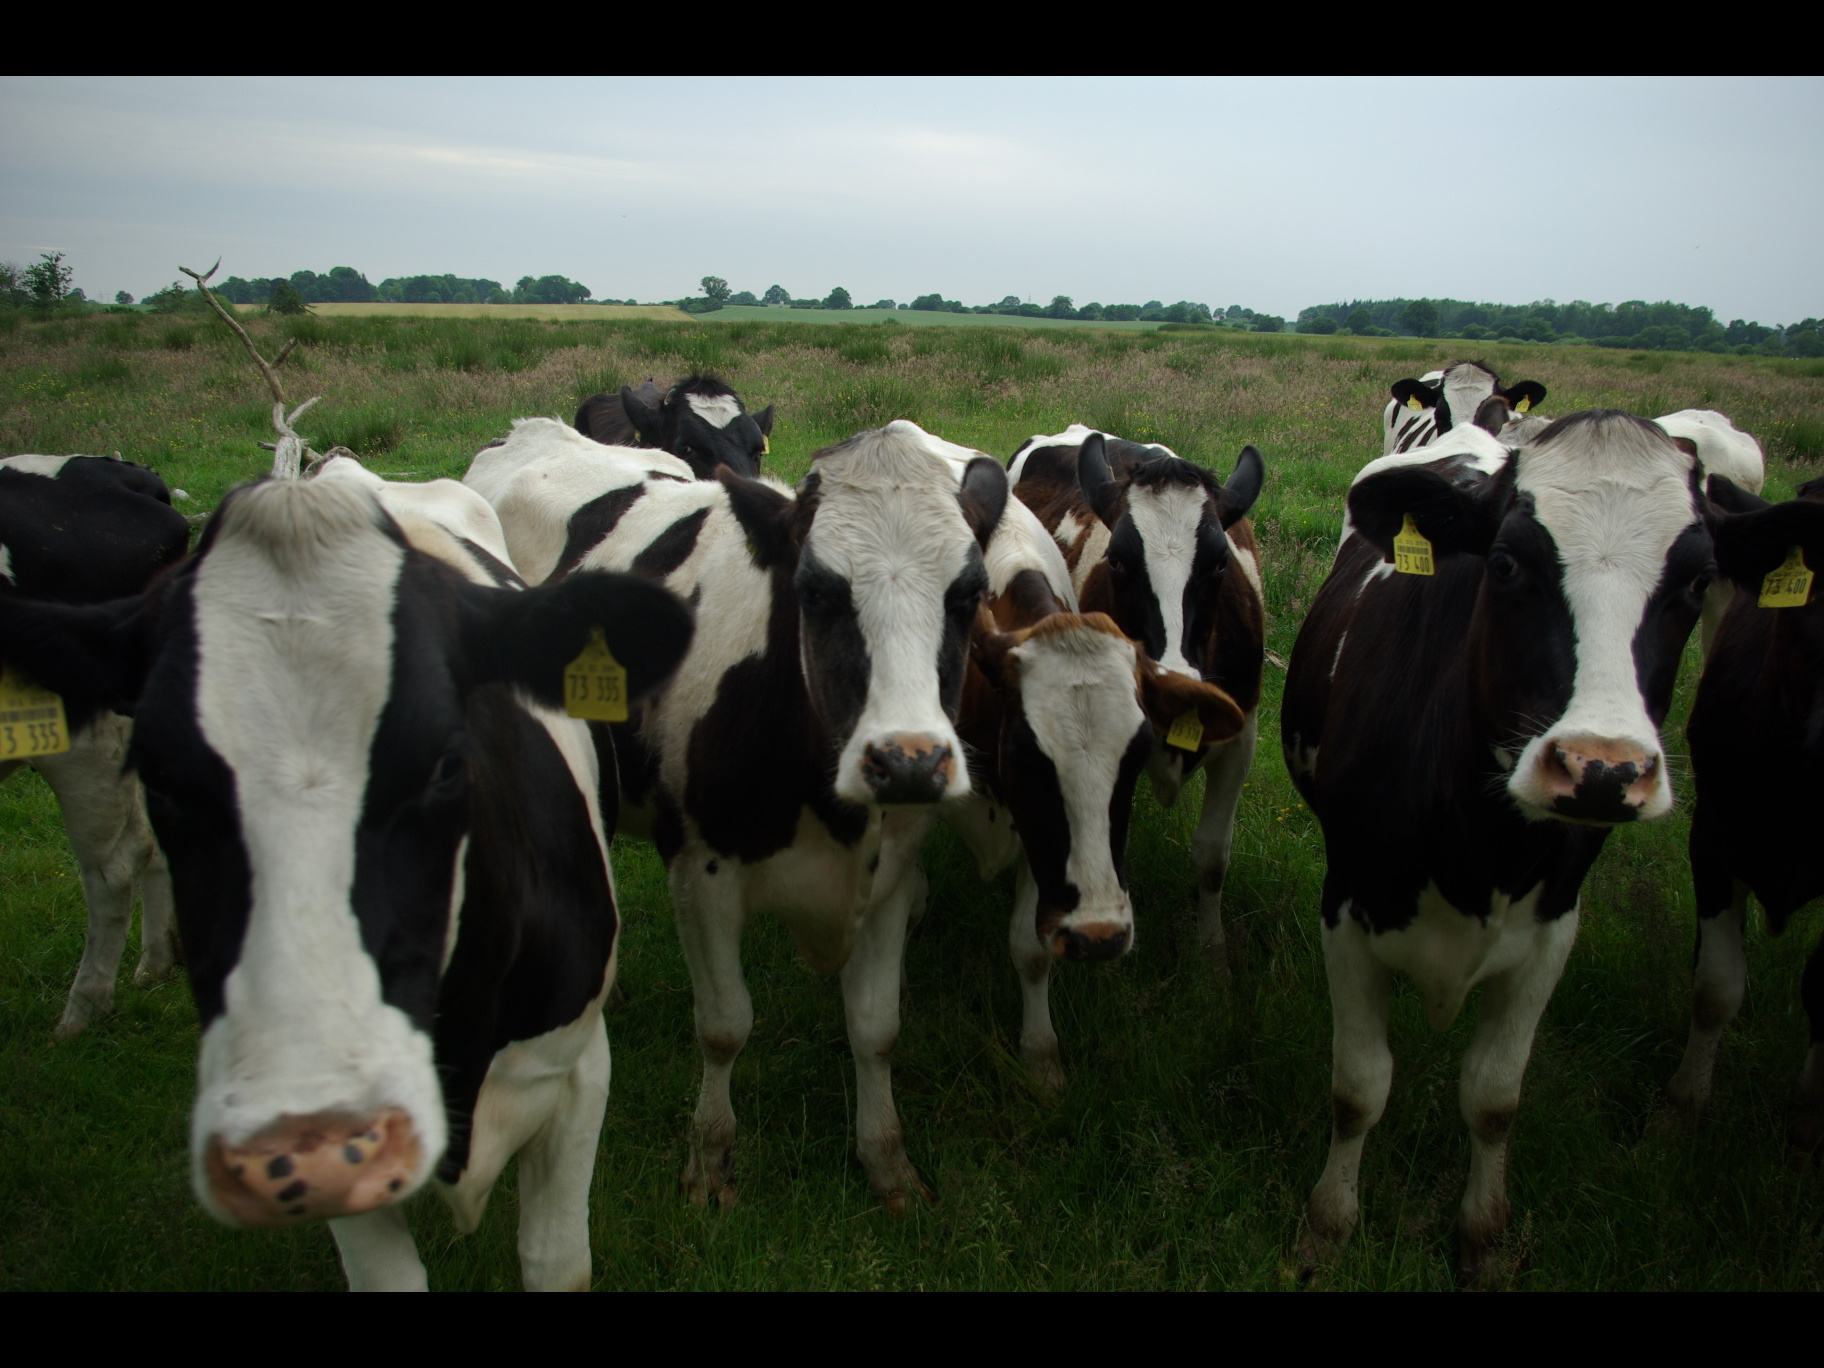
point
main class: Grassland
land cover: Grassland without tree/shrub cover
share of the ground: > 75 %
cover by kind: herbaceous plants 100 %
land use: Agriculture (excluding fallow land and kitchen gardens)
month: June
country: DE
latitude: 54.5341
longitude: 9.8919
